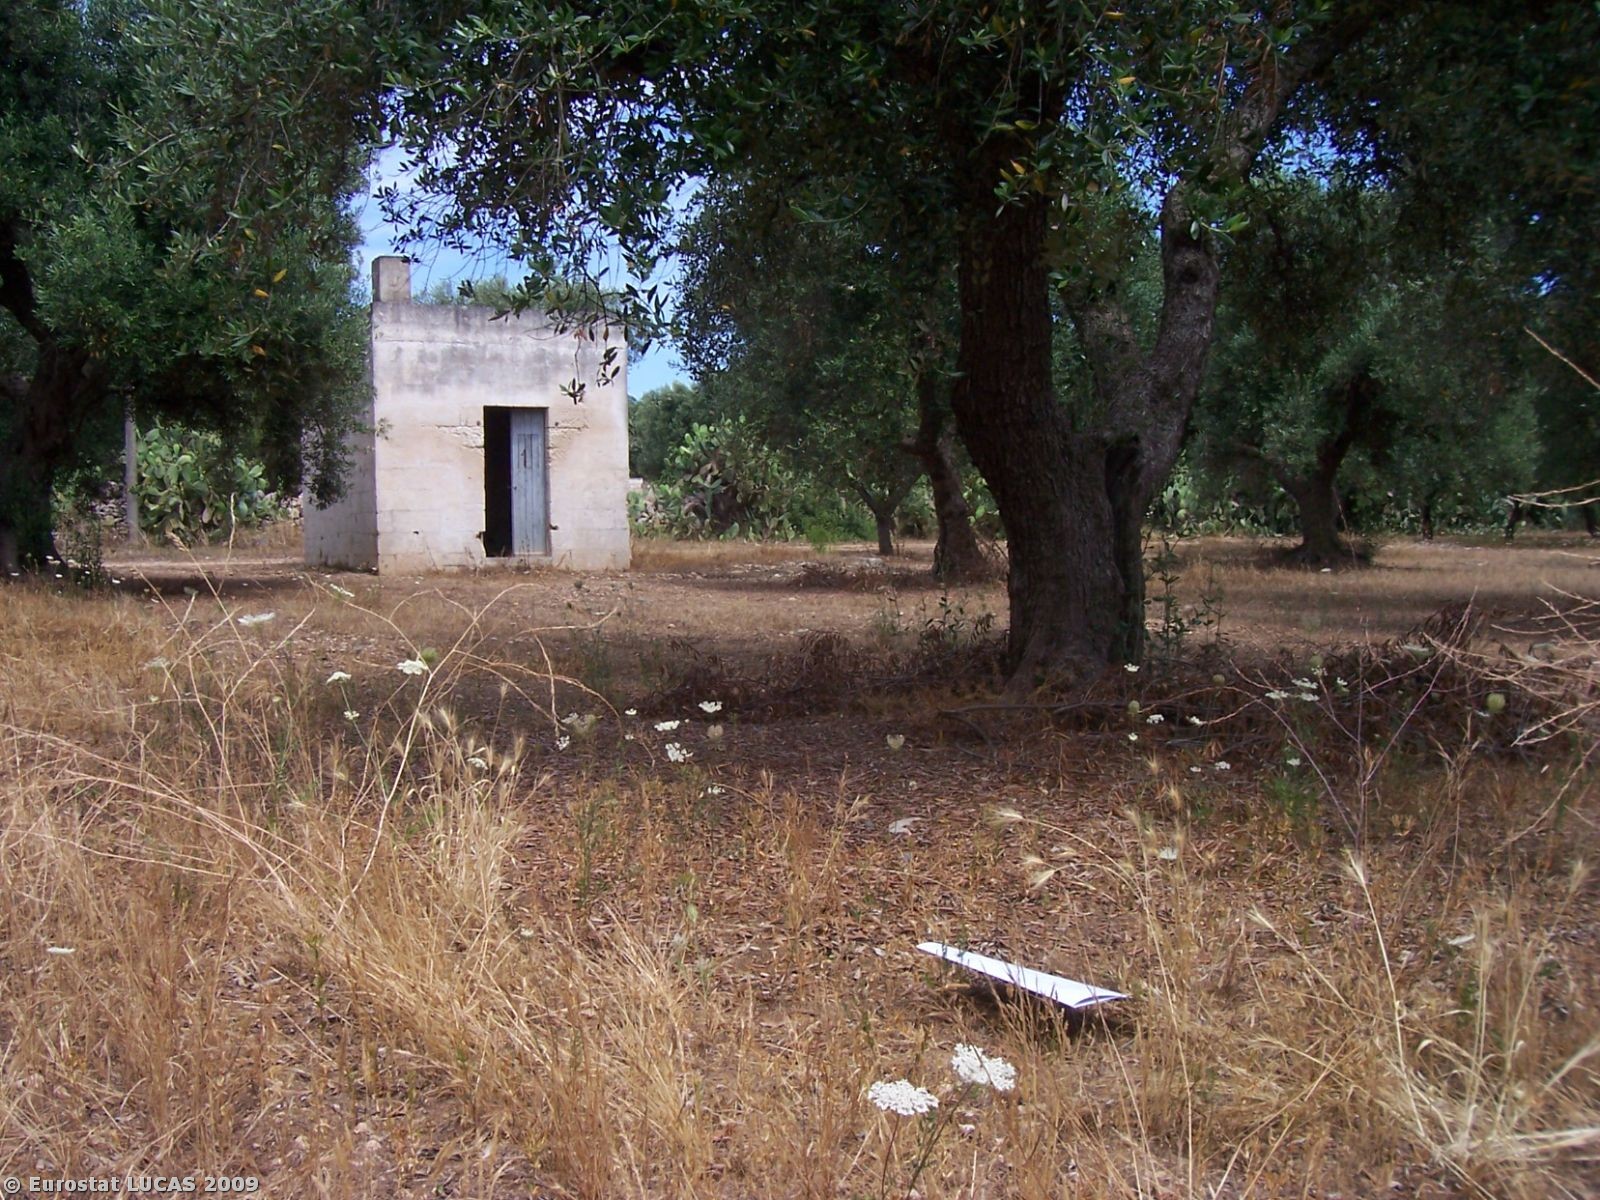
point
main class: Cropland
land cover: Olive groves
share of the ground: 25 - 50 %
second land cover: Bare land
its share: 50 - 75 %
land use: Agriculture (excluding fallow land and kitchen gardens)
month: June
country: IT
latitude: 40.3255
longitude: 17.4952
